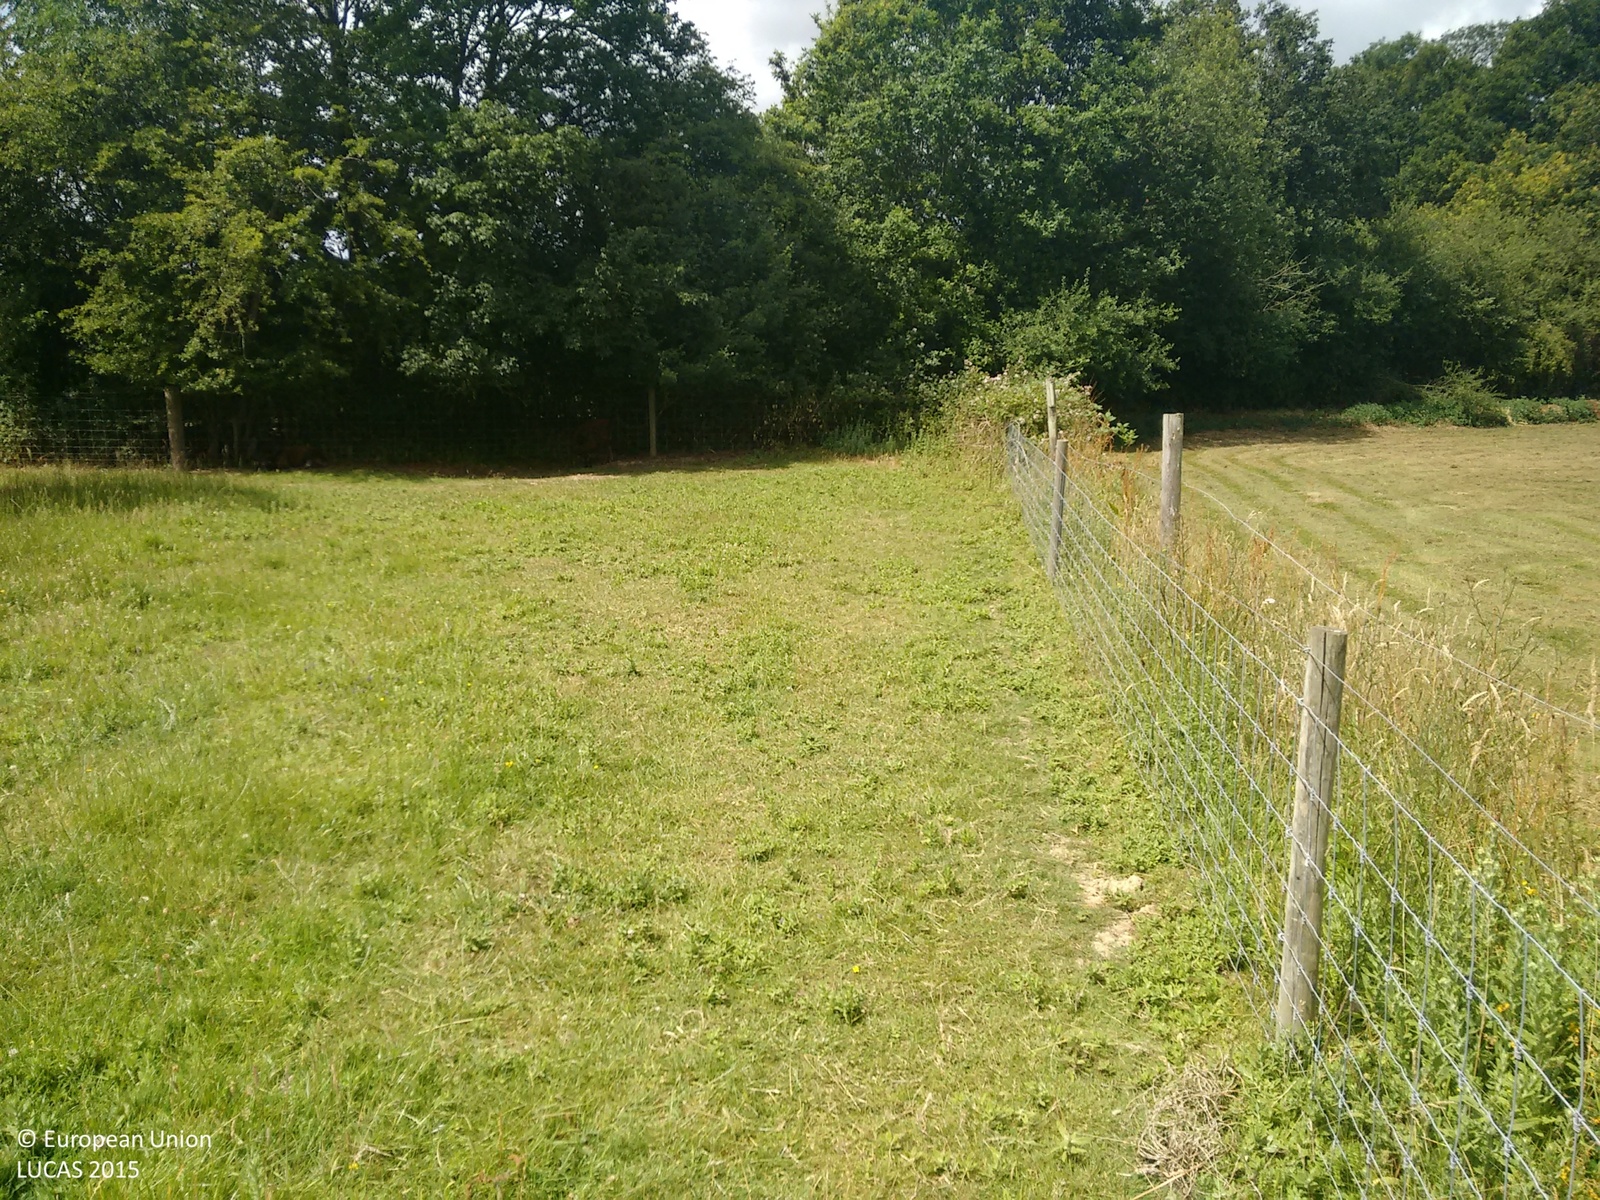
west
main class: Grassland
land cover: Grassland without tree/shrub cover
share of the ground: > 75 %
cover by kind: herbaceous plants 100 %
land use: Residential
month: July
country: GB
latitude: 51.0459
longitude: -0.4359
